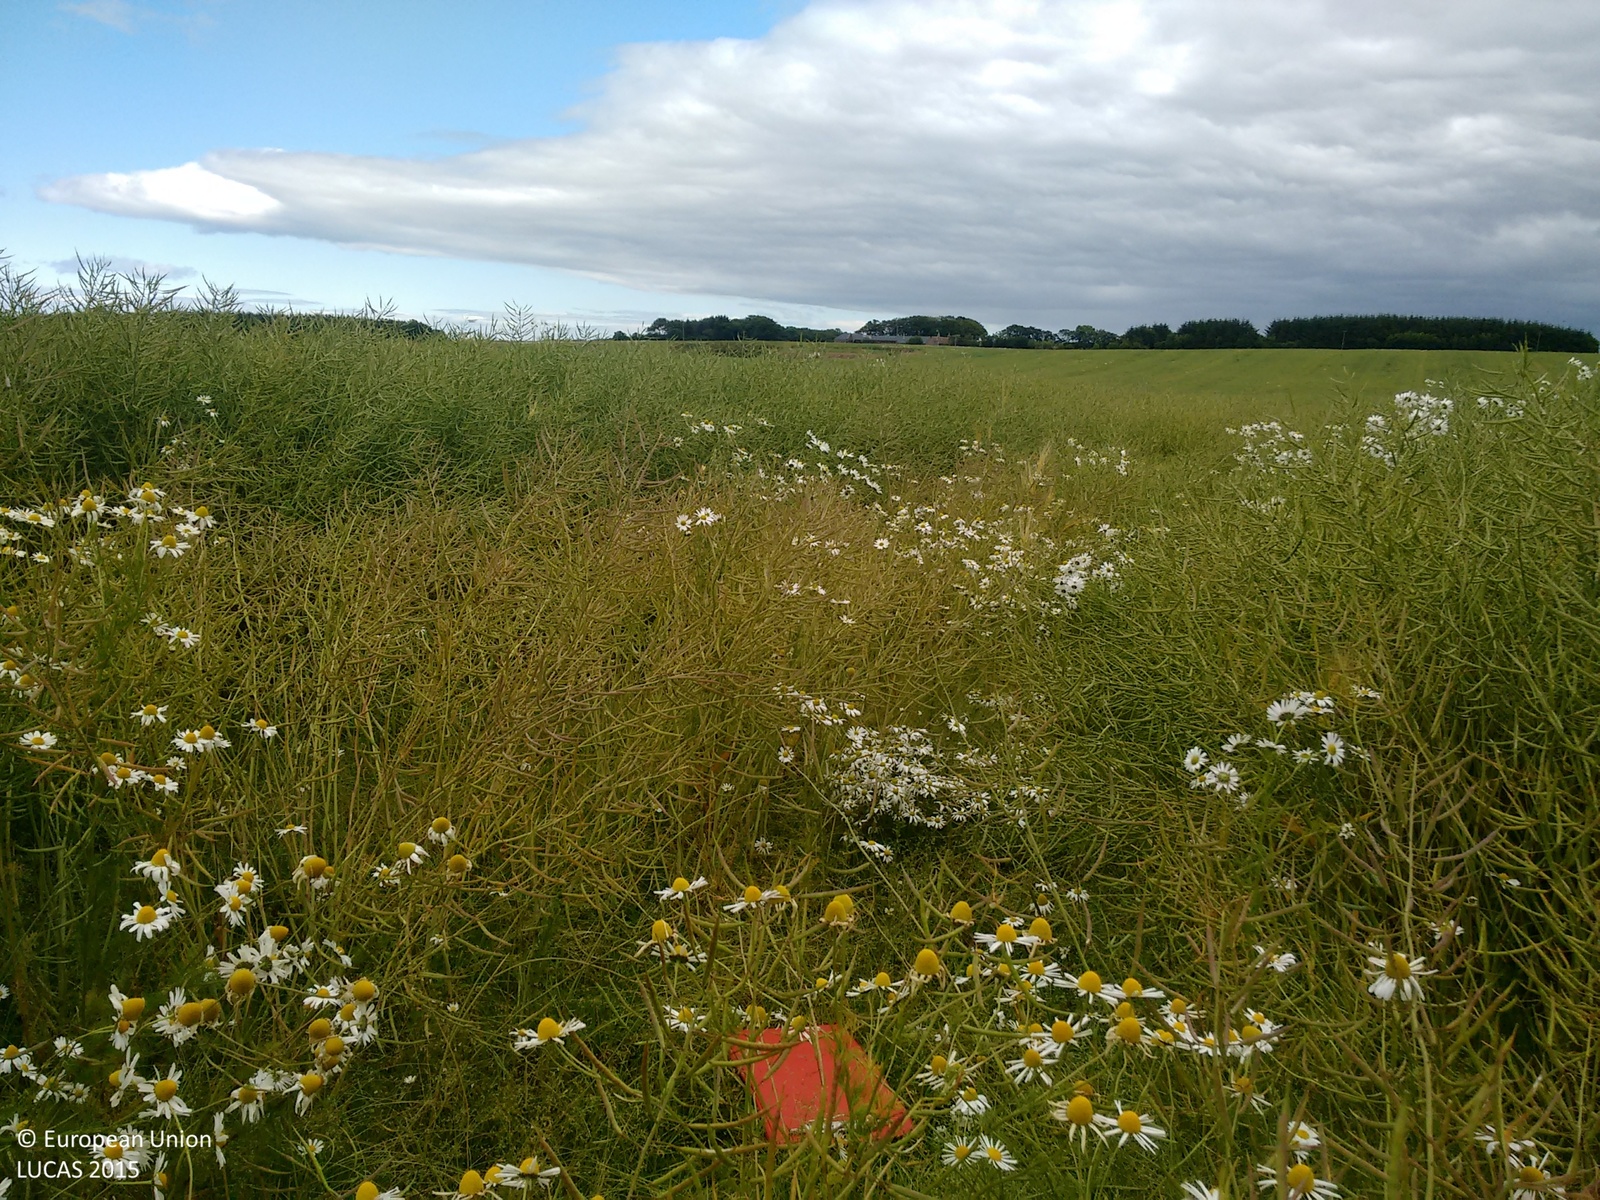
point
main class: Cropland
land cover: Rape and turnip rape
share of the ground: > 75 %
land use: Agriculture (excluding fallow land and kitchen gardens)
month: July
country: GB
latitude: 57.4996
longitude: -1.9759
